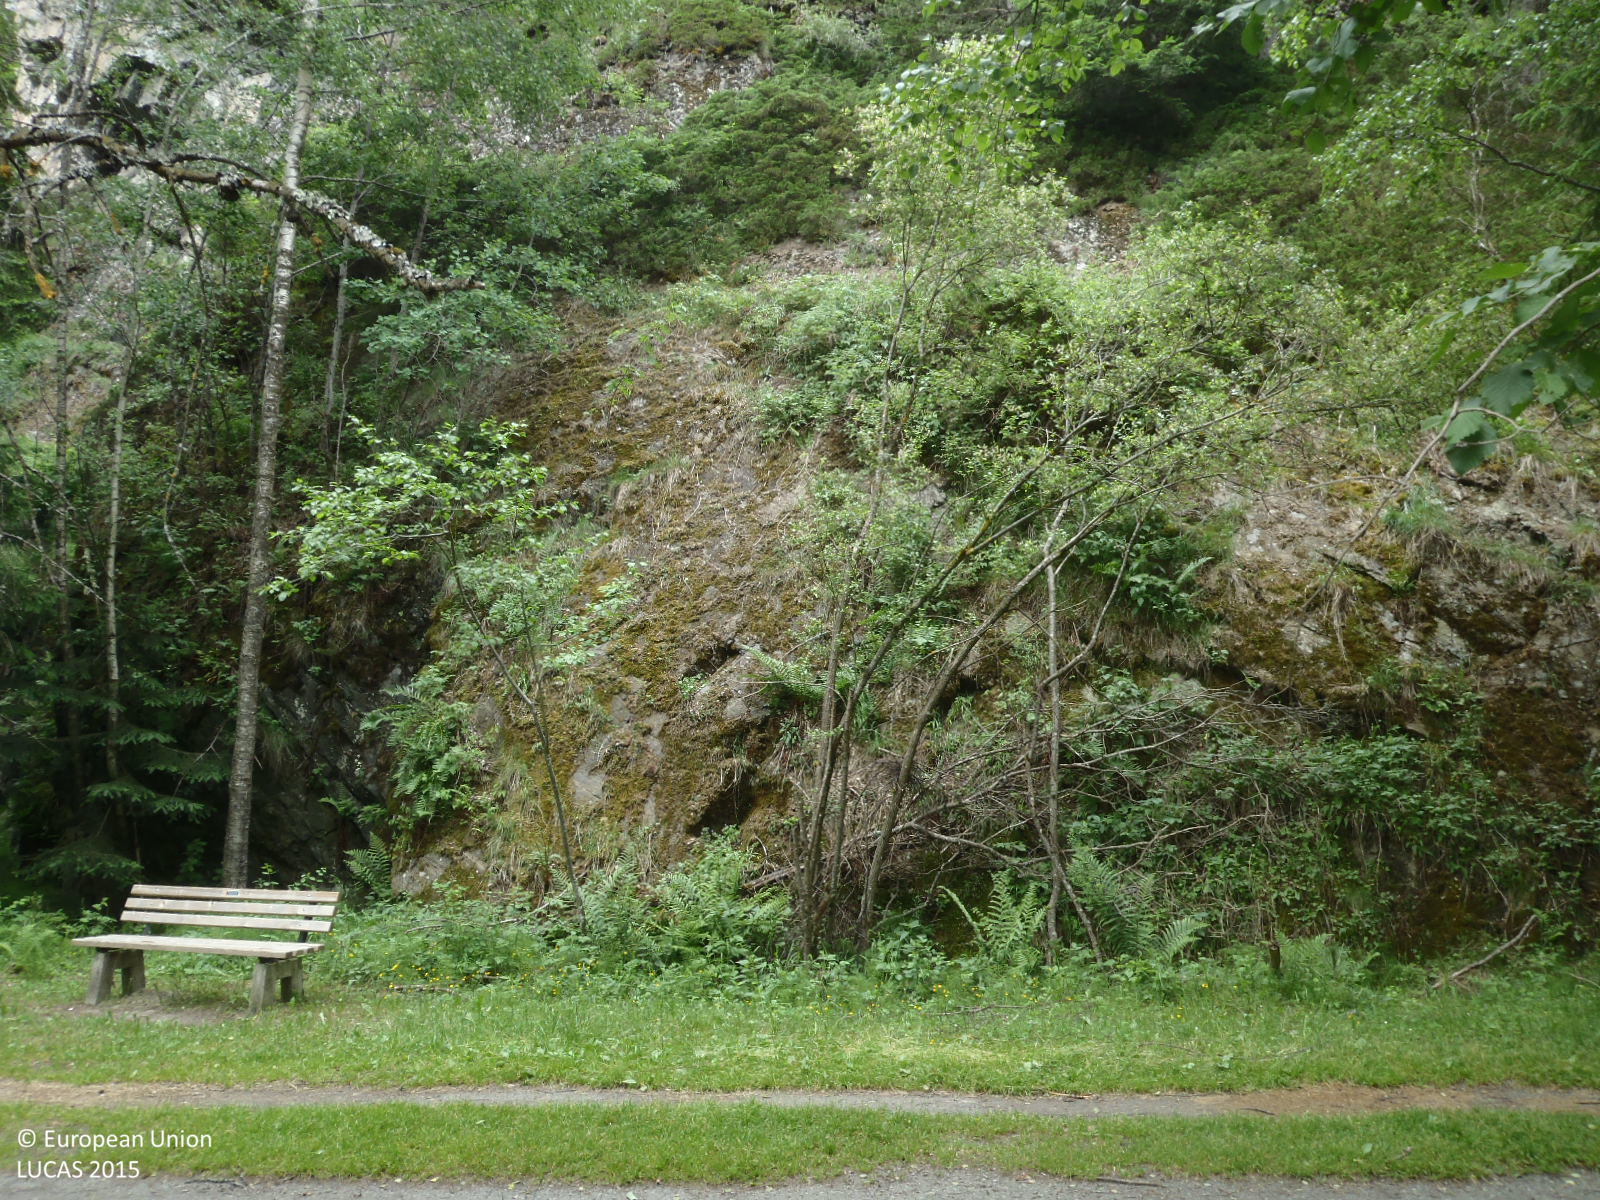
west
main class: Woodland
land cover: Pine dominated coniferous woodland
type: alpine coniferous forest
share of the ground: > 75 %
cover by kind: coniferous forest trees 85 %, shrubs 10 %, consolidated bare surface 5 %
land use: Semi-natural and natural areas not in use
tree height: > 5 m
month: June
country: AT
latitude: 47.0673
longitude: 10.9603
